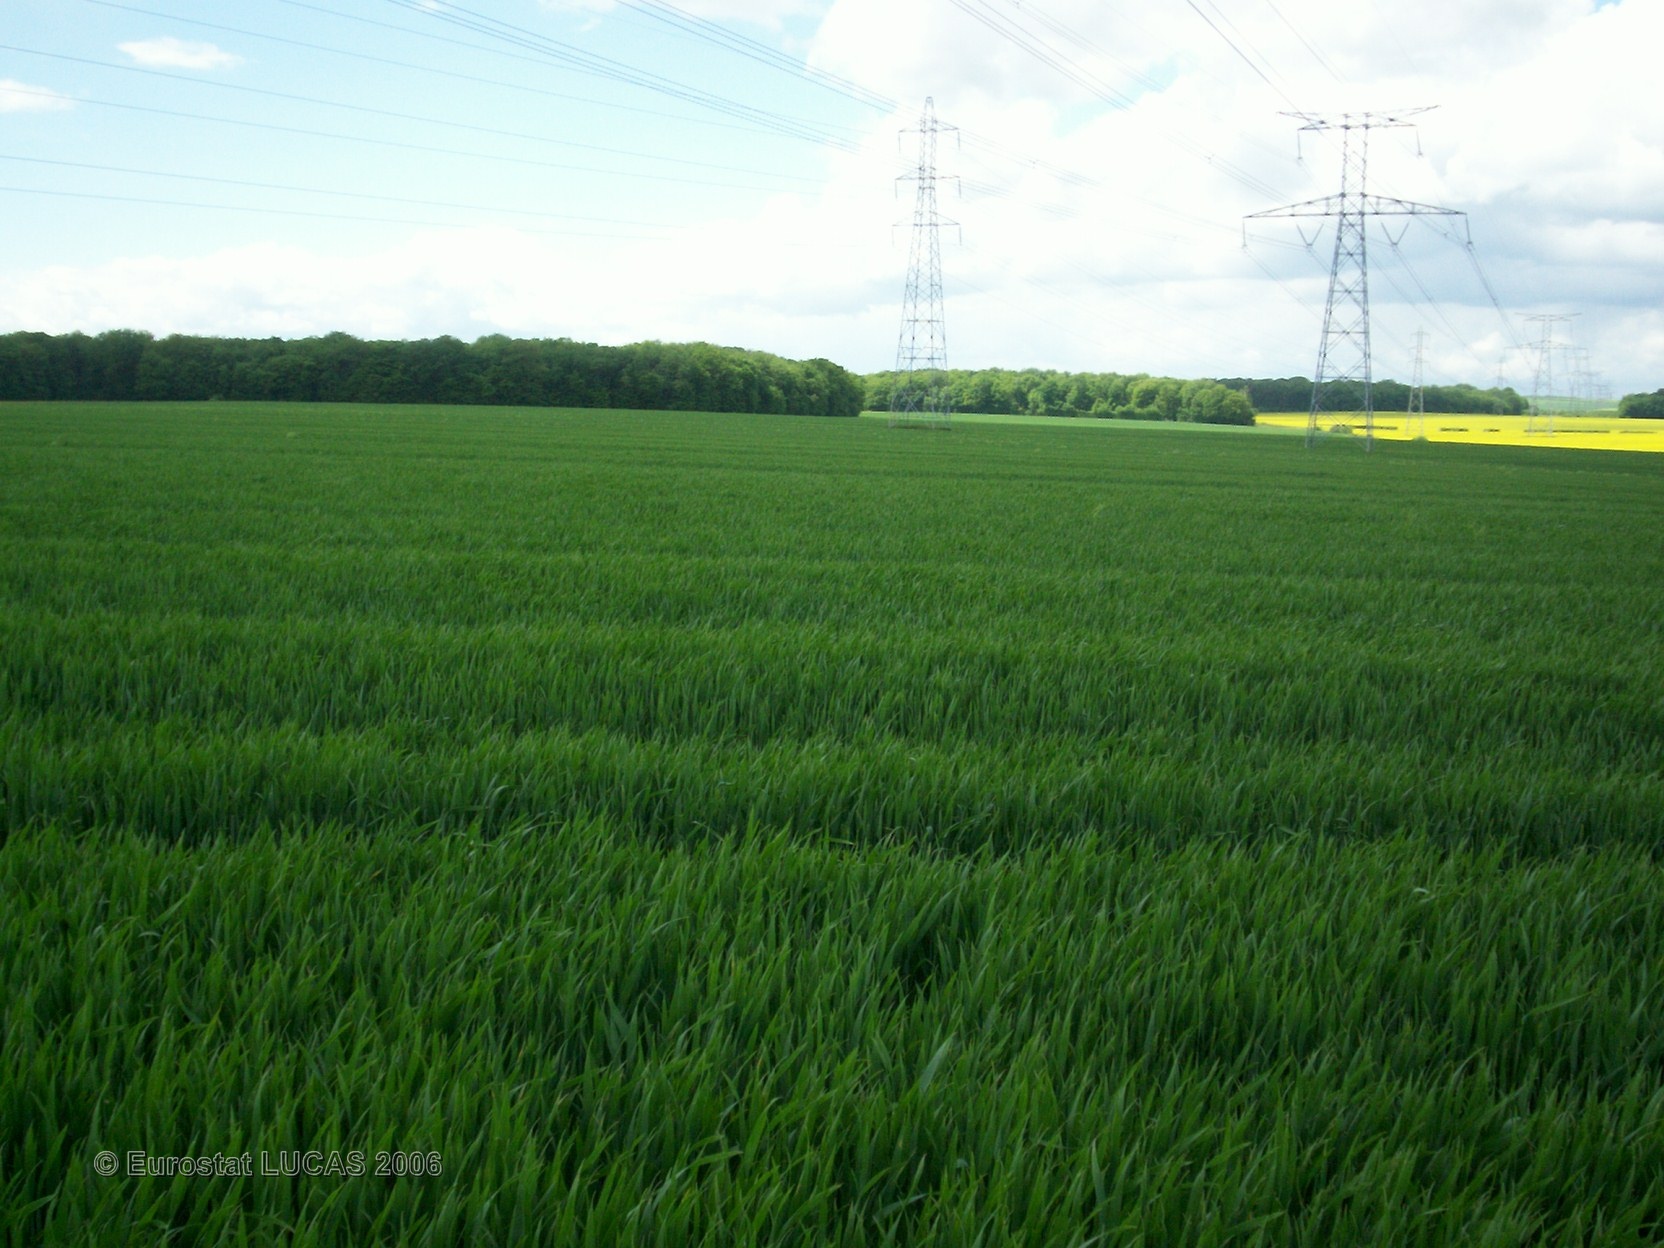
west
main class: Cropland
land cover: Common wheat
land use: Agriculture (excluding fallow land and kitchen gardens)
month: May
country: FR
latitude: 49.2628
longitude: 5.8630
